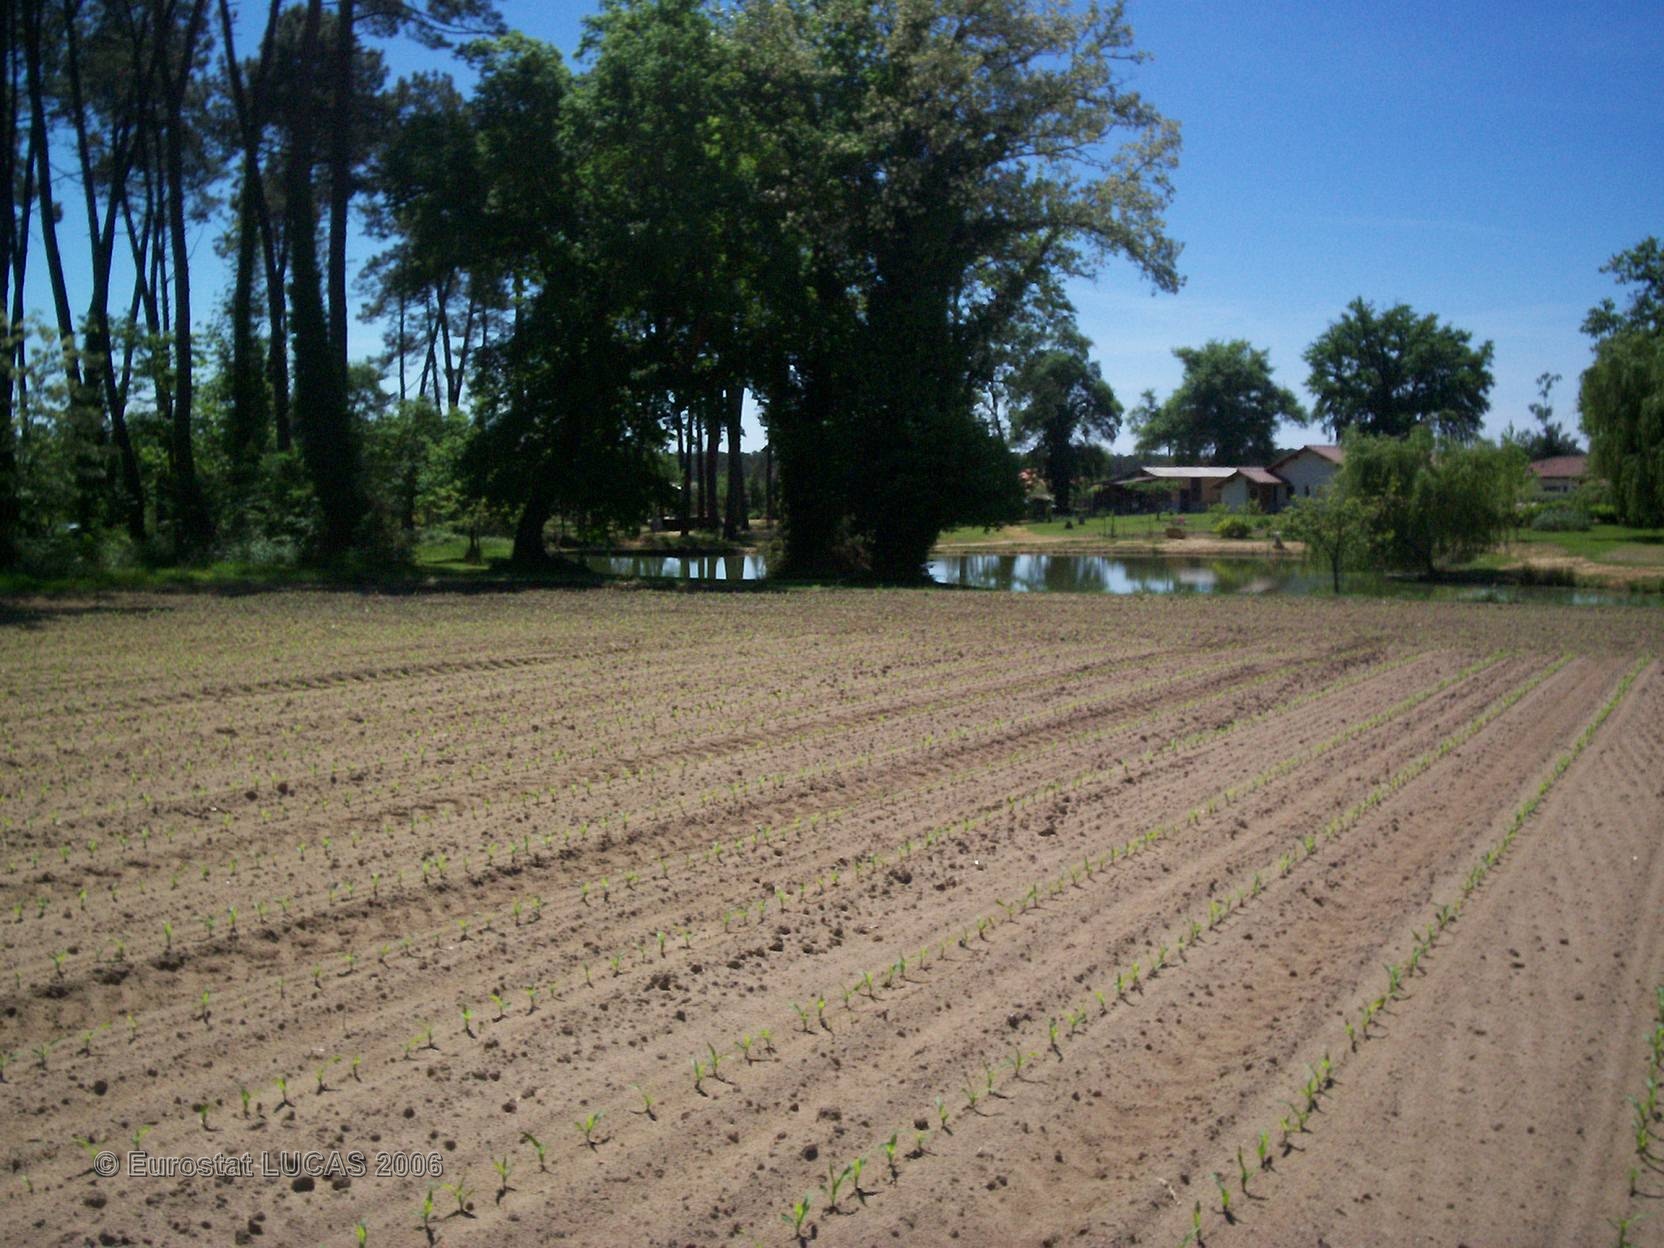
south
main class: Cropland
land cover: Maize
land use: Agriculture (excluding fallow land and kitchen gardens)
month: May
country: FR
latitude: 43.9905
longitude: -0.7505
